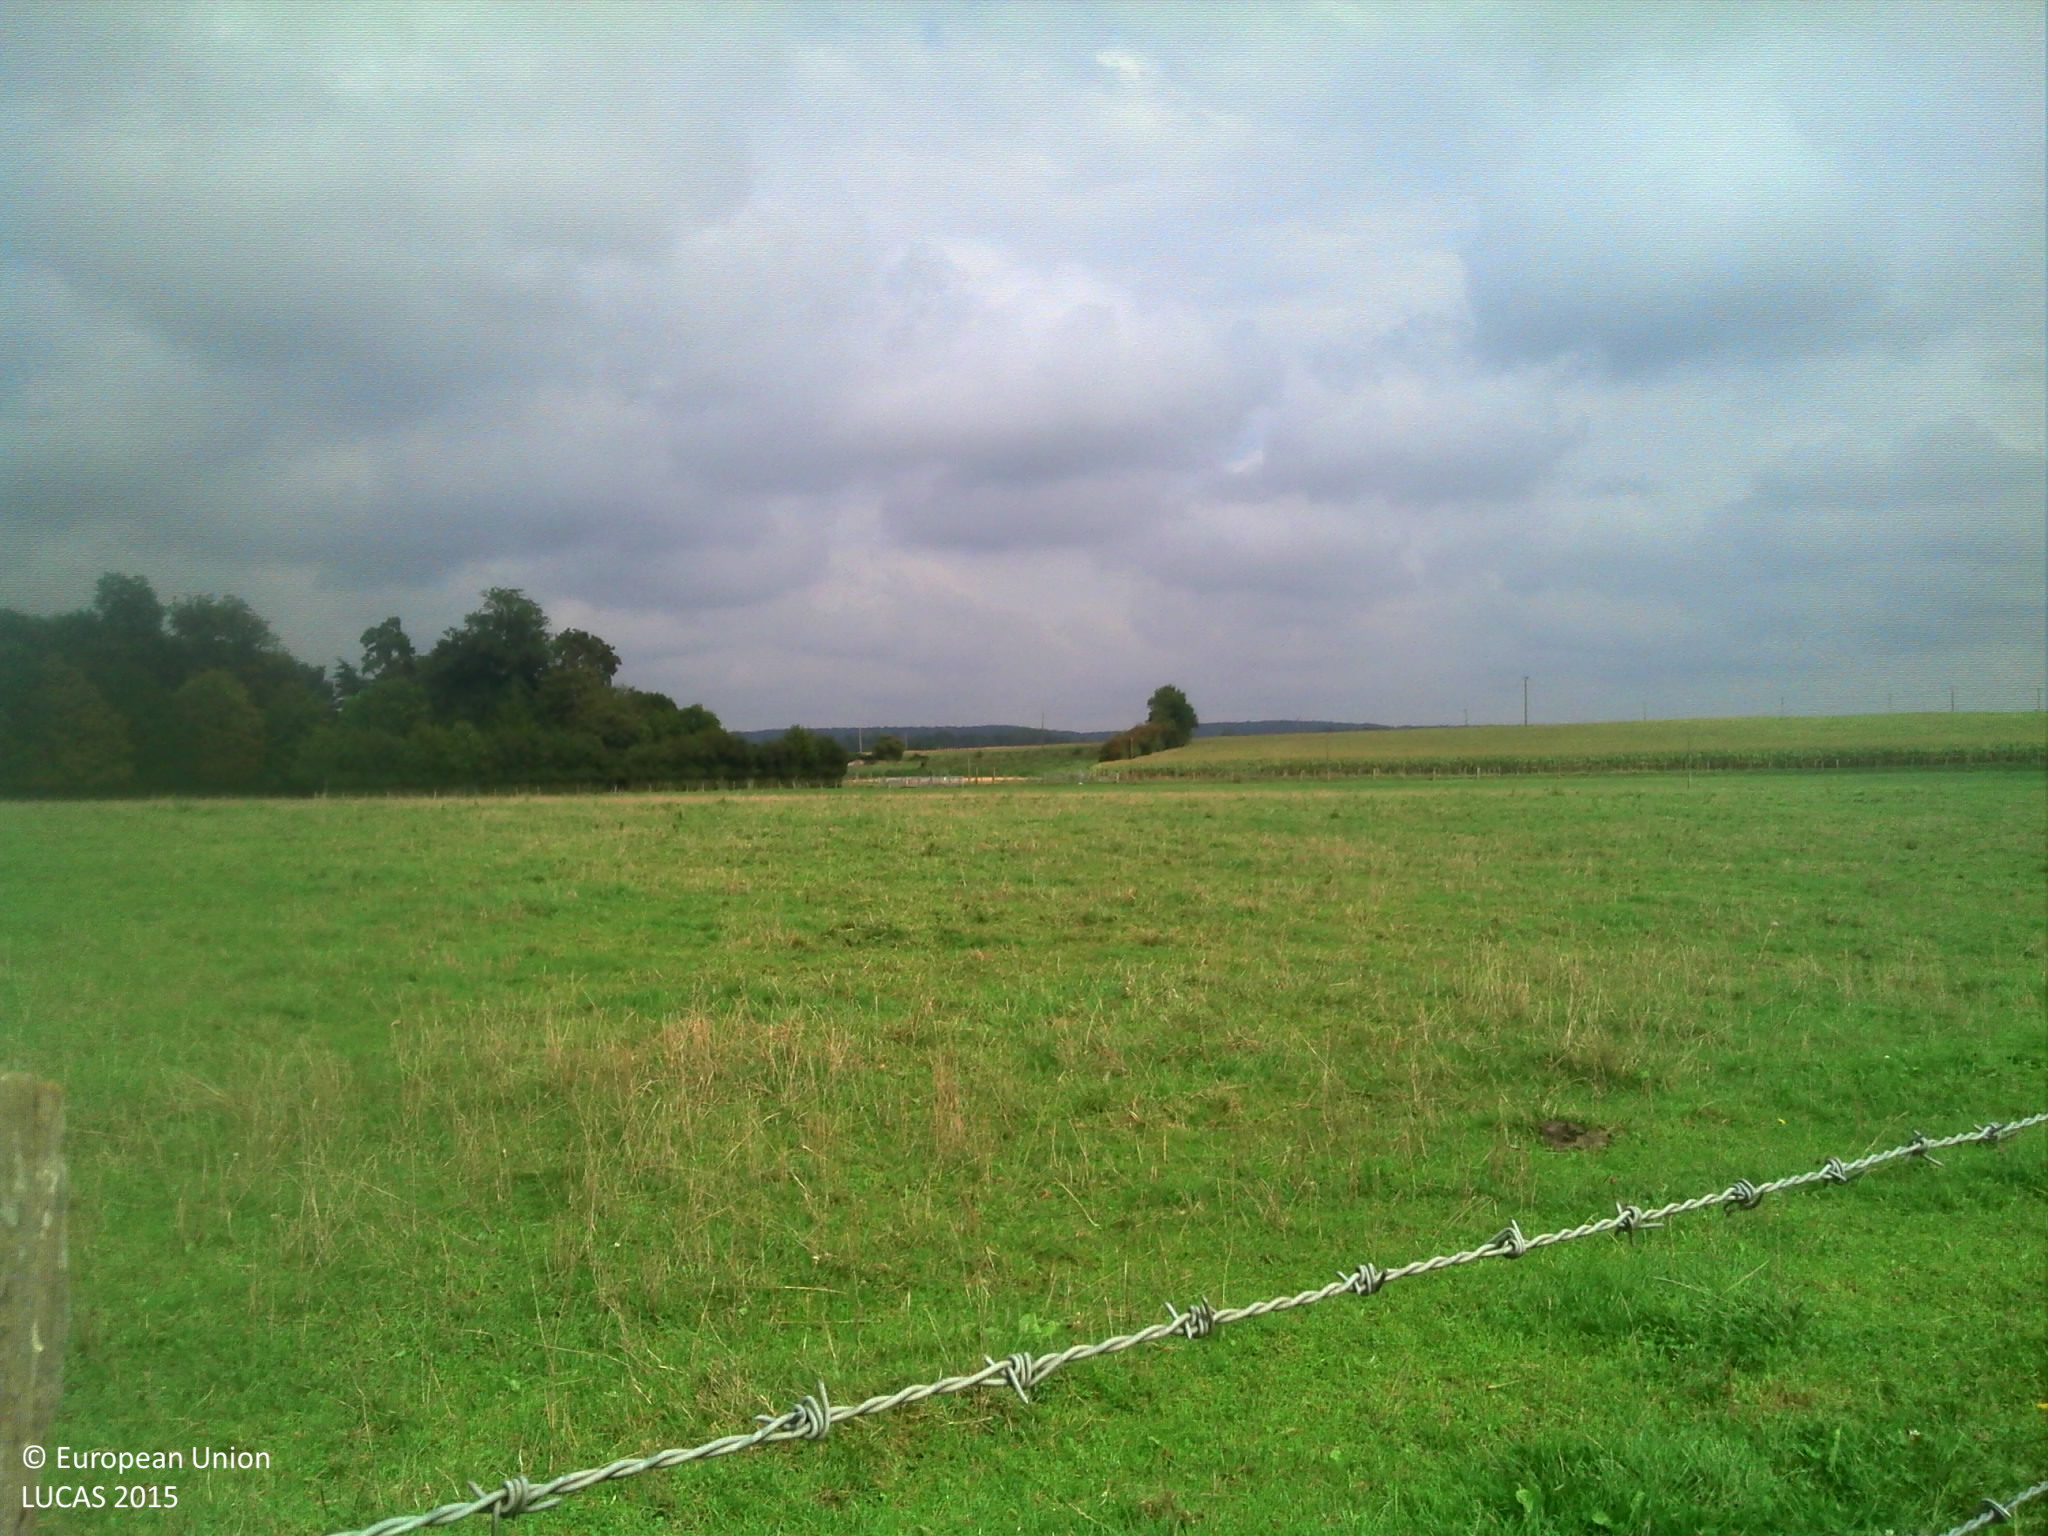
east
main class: Grassland
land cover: Grassland without tree/shrub cover
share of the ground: > 75 %
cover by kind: herbaceous plants 100 %
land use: Agriculture (excluding fallow land and kitchen gardens)
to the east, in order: Grassland without tree/shrub cover; Fences; Electric lines; Grass margins; Paved roads, cycling and walking lanes; Grass margins; Fences; Maize
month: August
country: FR
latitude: 48.5067
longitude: 0.5686
